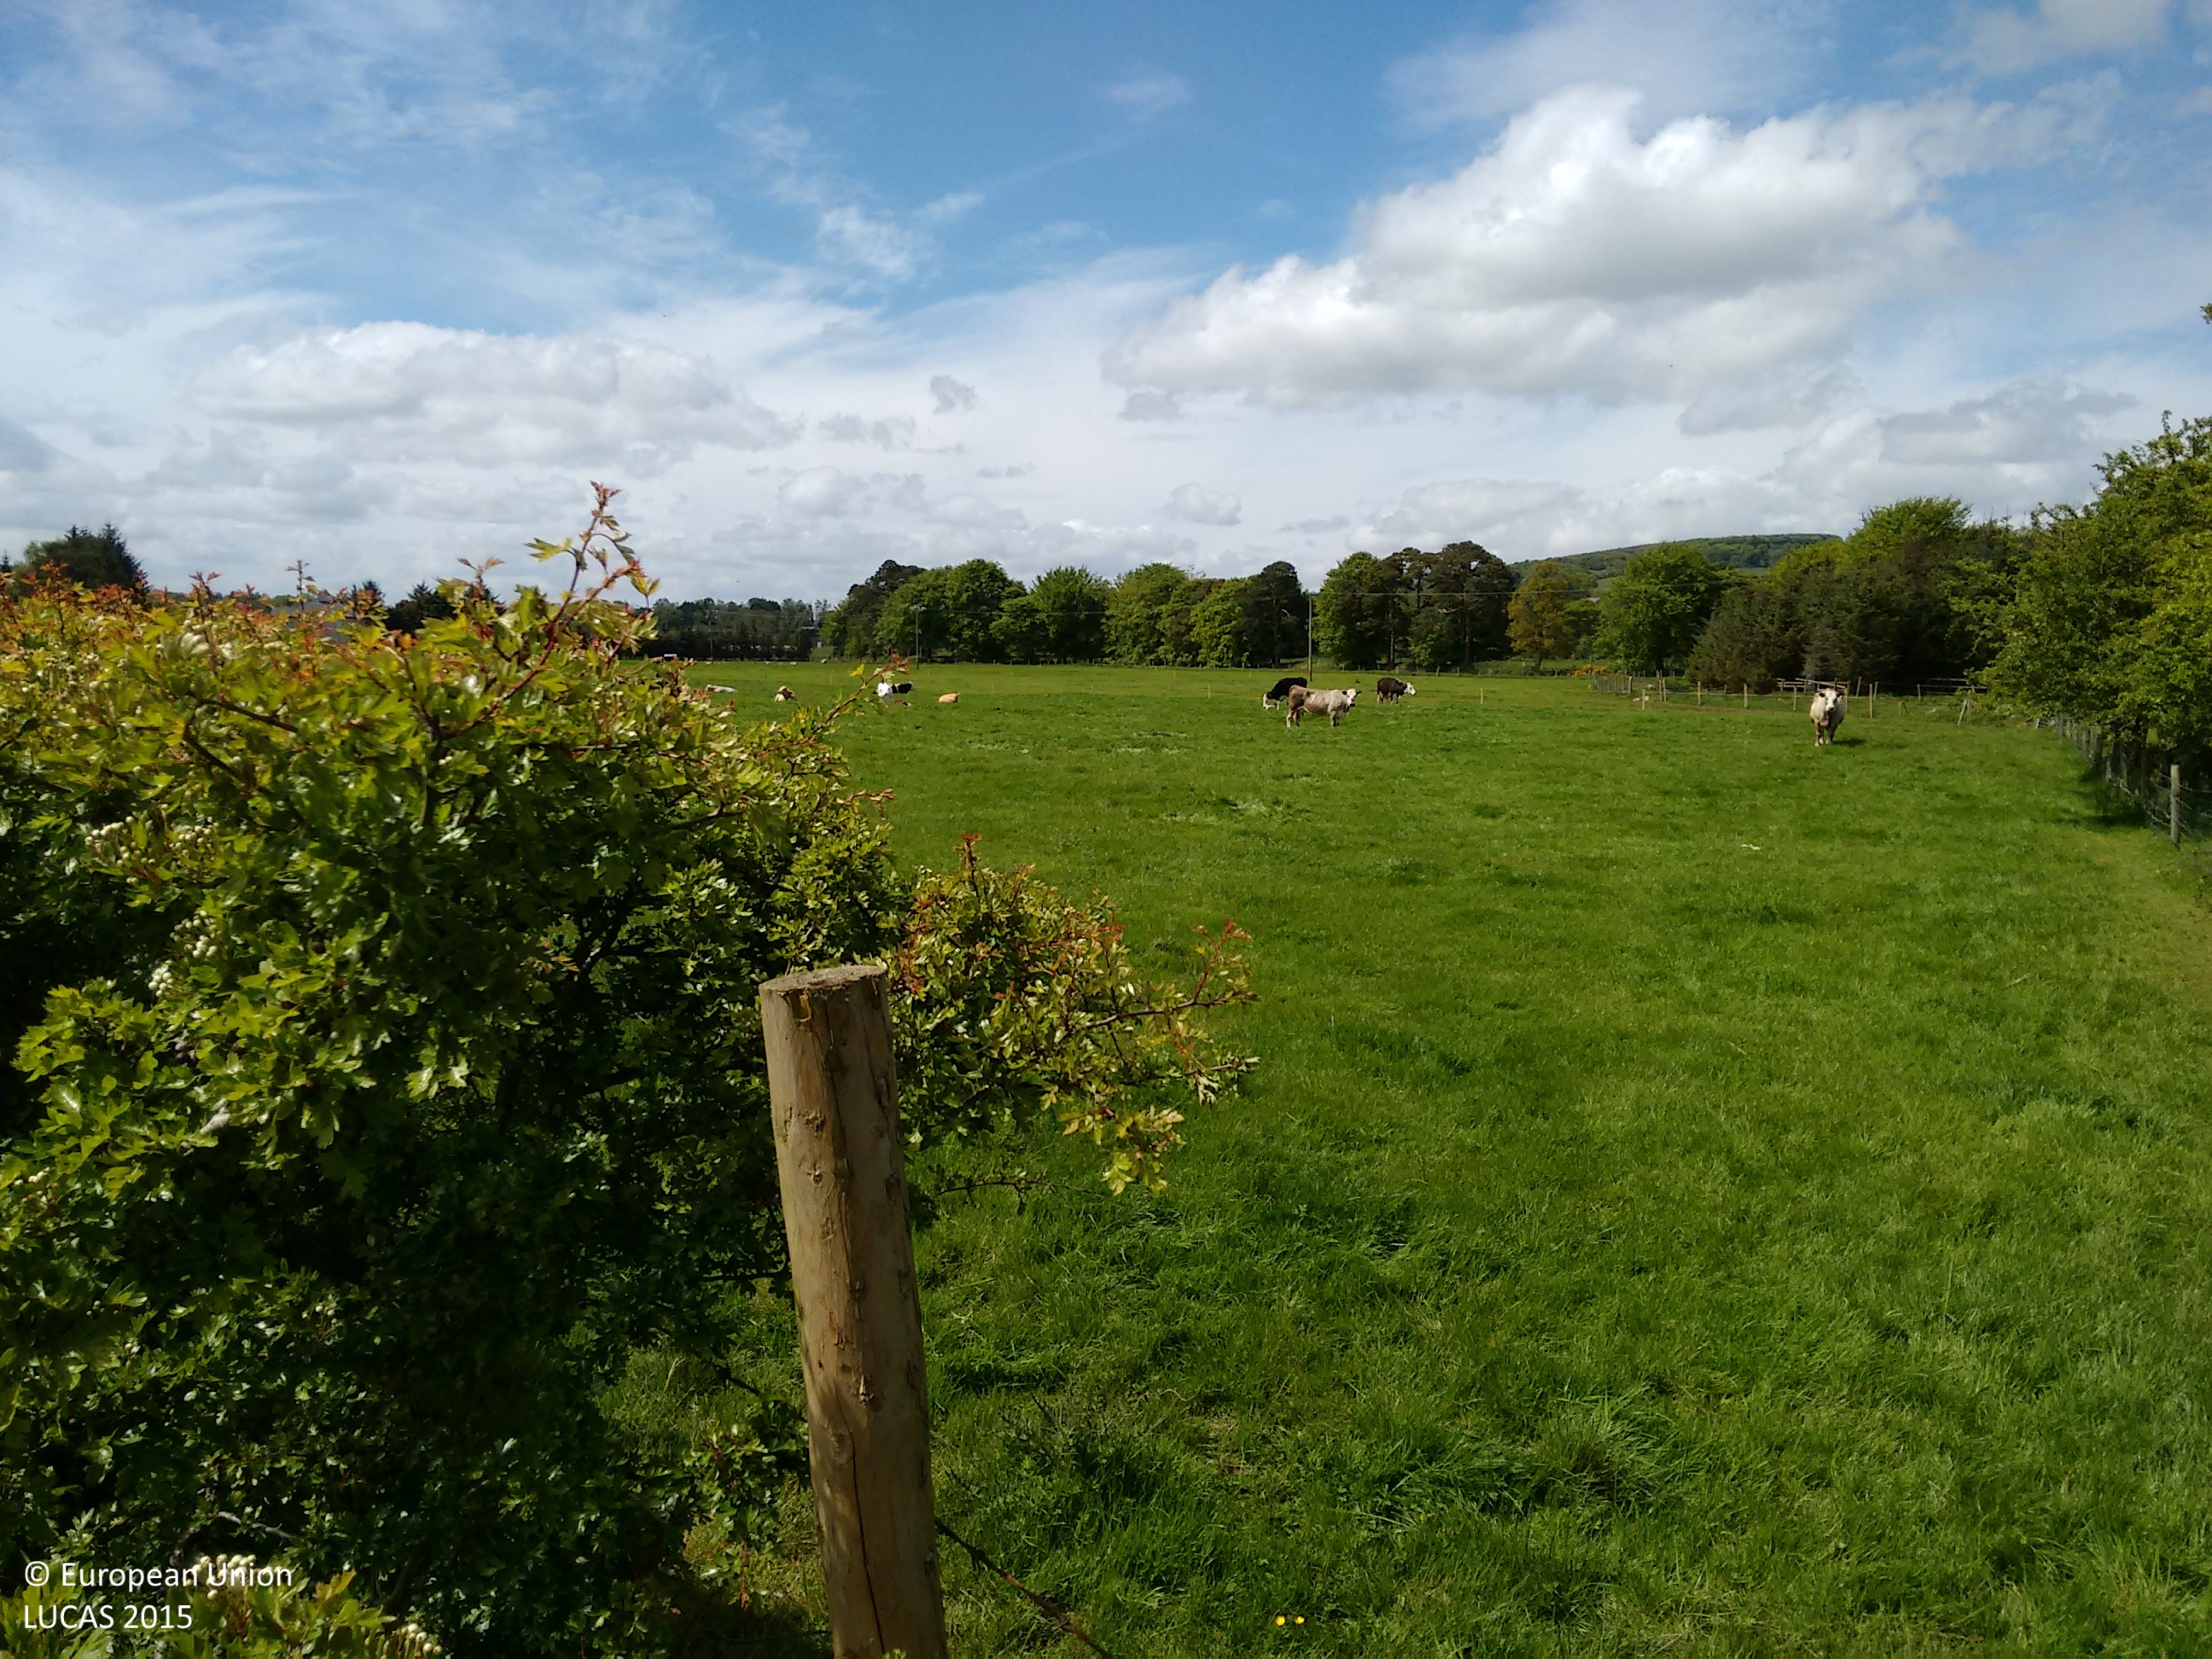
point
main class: Grassland
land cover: Grassland without tree/shrub cover
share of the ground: > 75 %
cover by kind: herbaceous plants 100 %
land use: Agriculture (excluding fallow land and kitchen gardens)
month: June
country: IE
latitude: 53.2189
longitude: -6.4654
